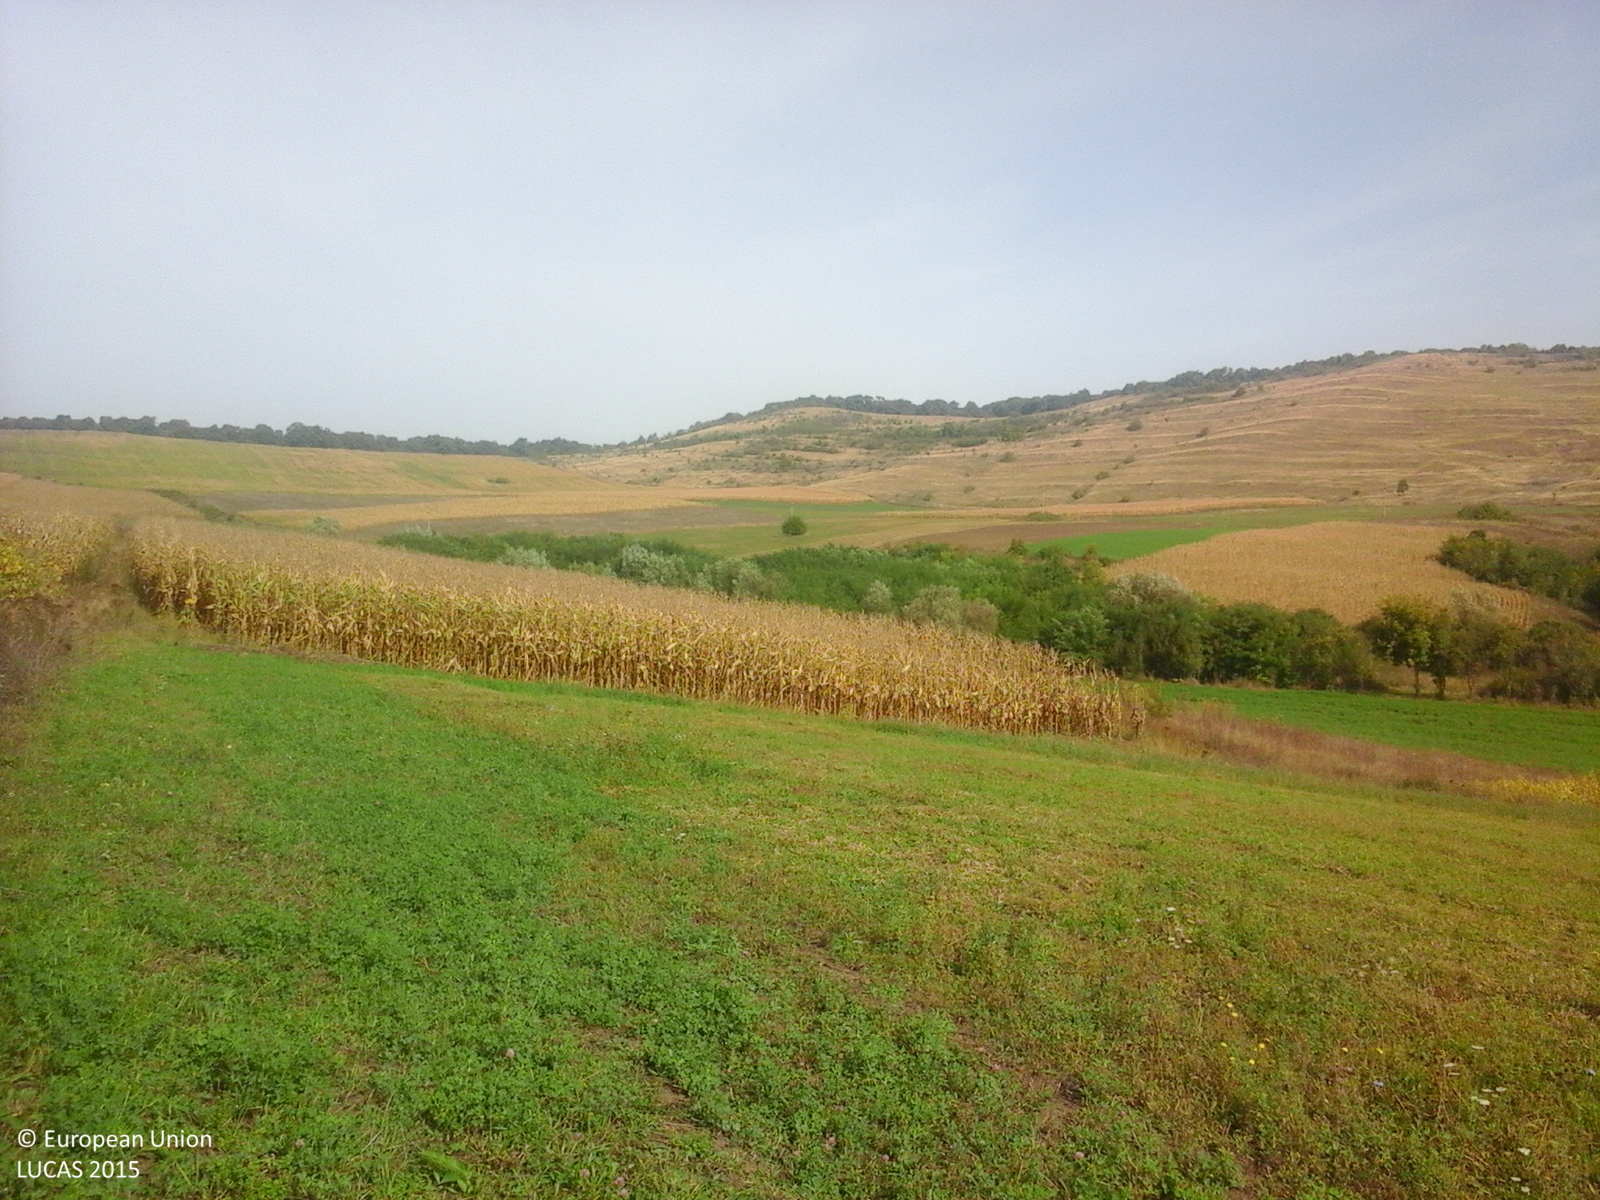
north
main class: Cropland
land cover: Maize
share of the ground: > 75 %
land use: Agriculture (excluding fallow land and kitchen gardens)
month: September
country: RO
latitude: 46.8615
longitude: 24.0502
